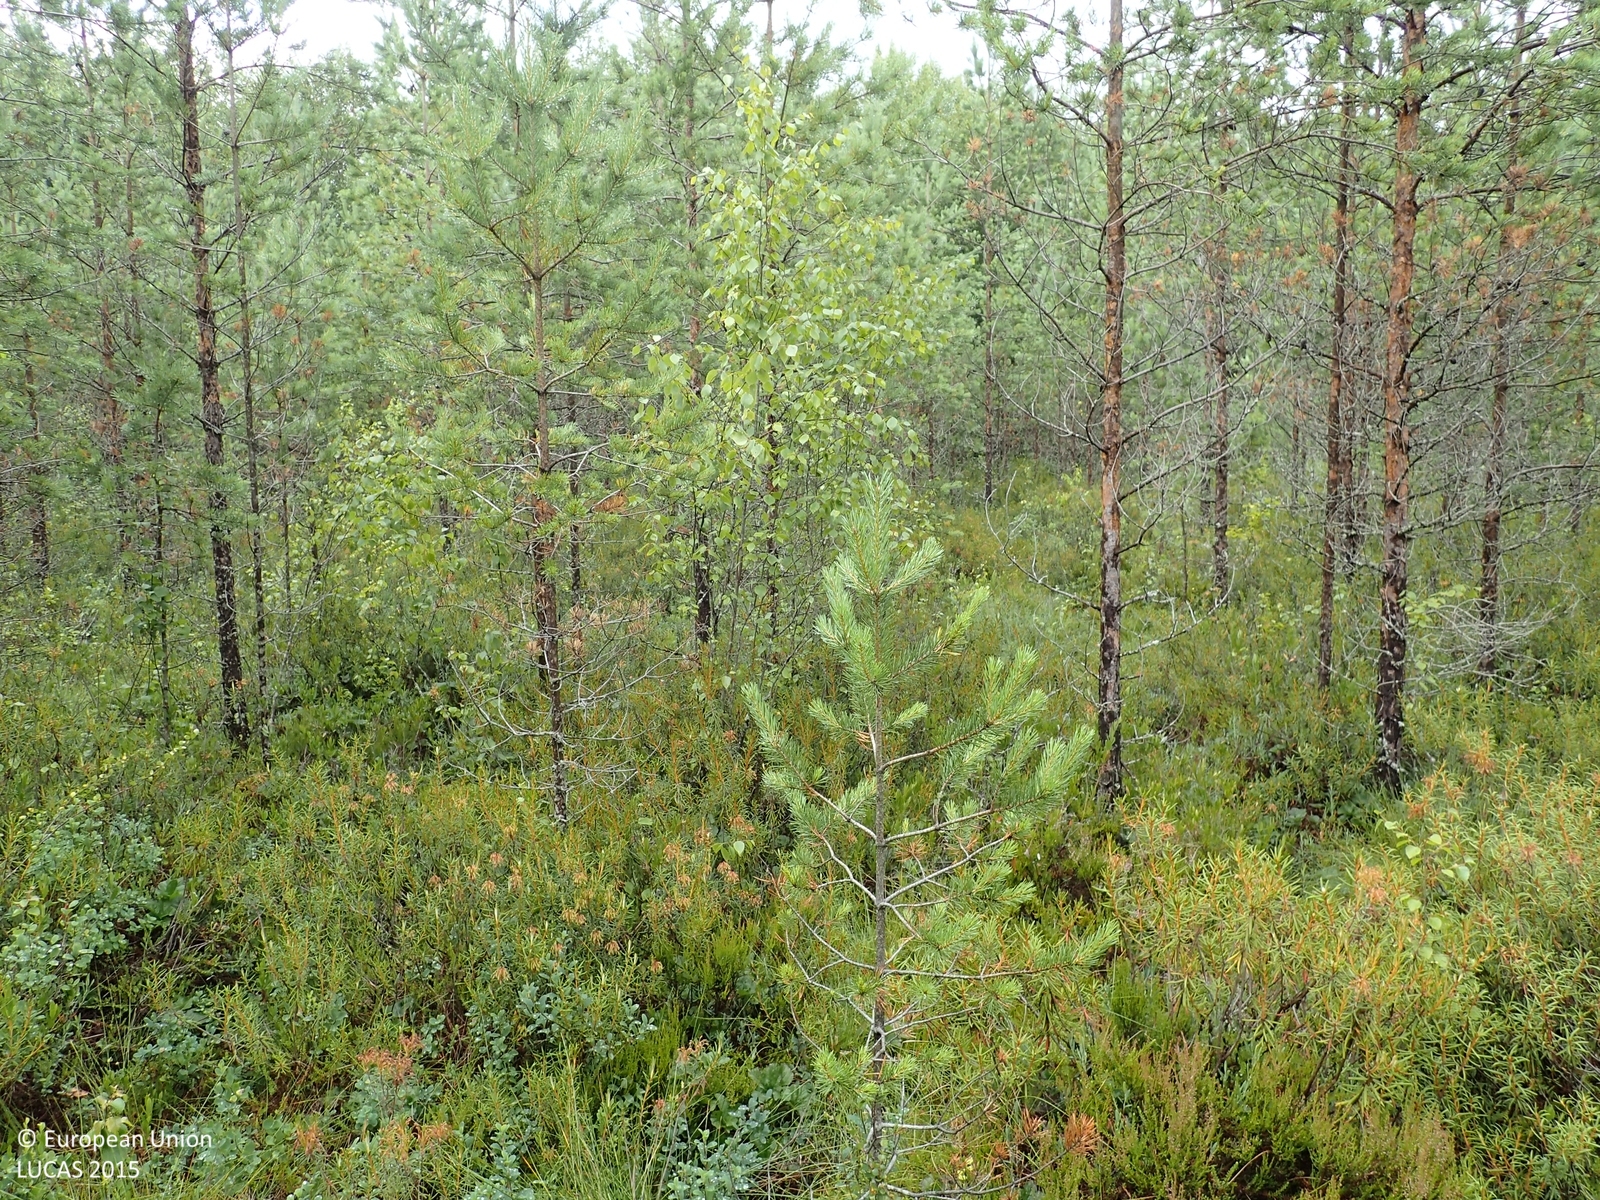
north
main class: Woodland
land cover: Pine dominated coniferous woodland
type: mire and swamp forests
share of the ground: 50 - 75 %
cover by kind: coniferous forest trees 50 %, shrubs 45 %, broadleaved forest trees 5 %
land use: Forestry
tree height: < 5 m
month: July
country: FI
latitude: 63.0127
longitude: 22.8359
